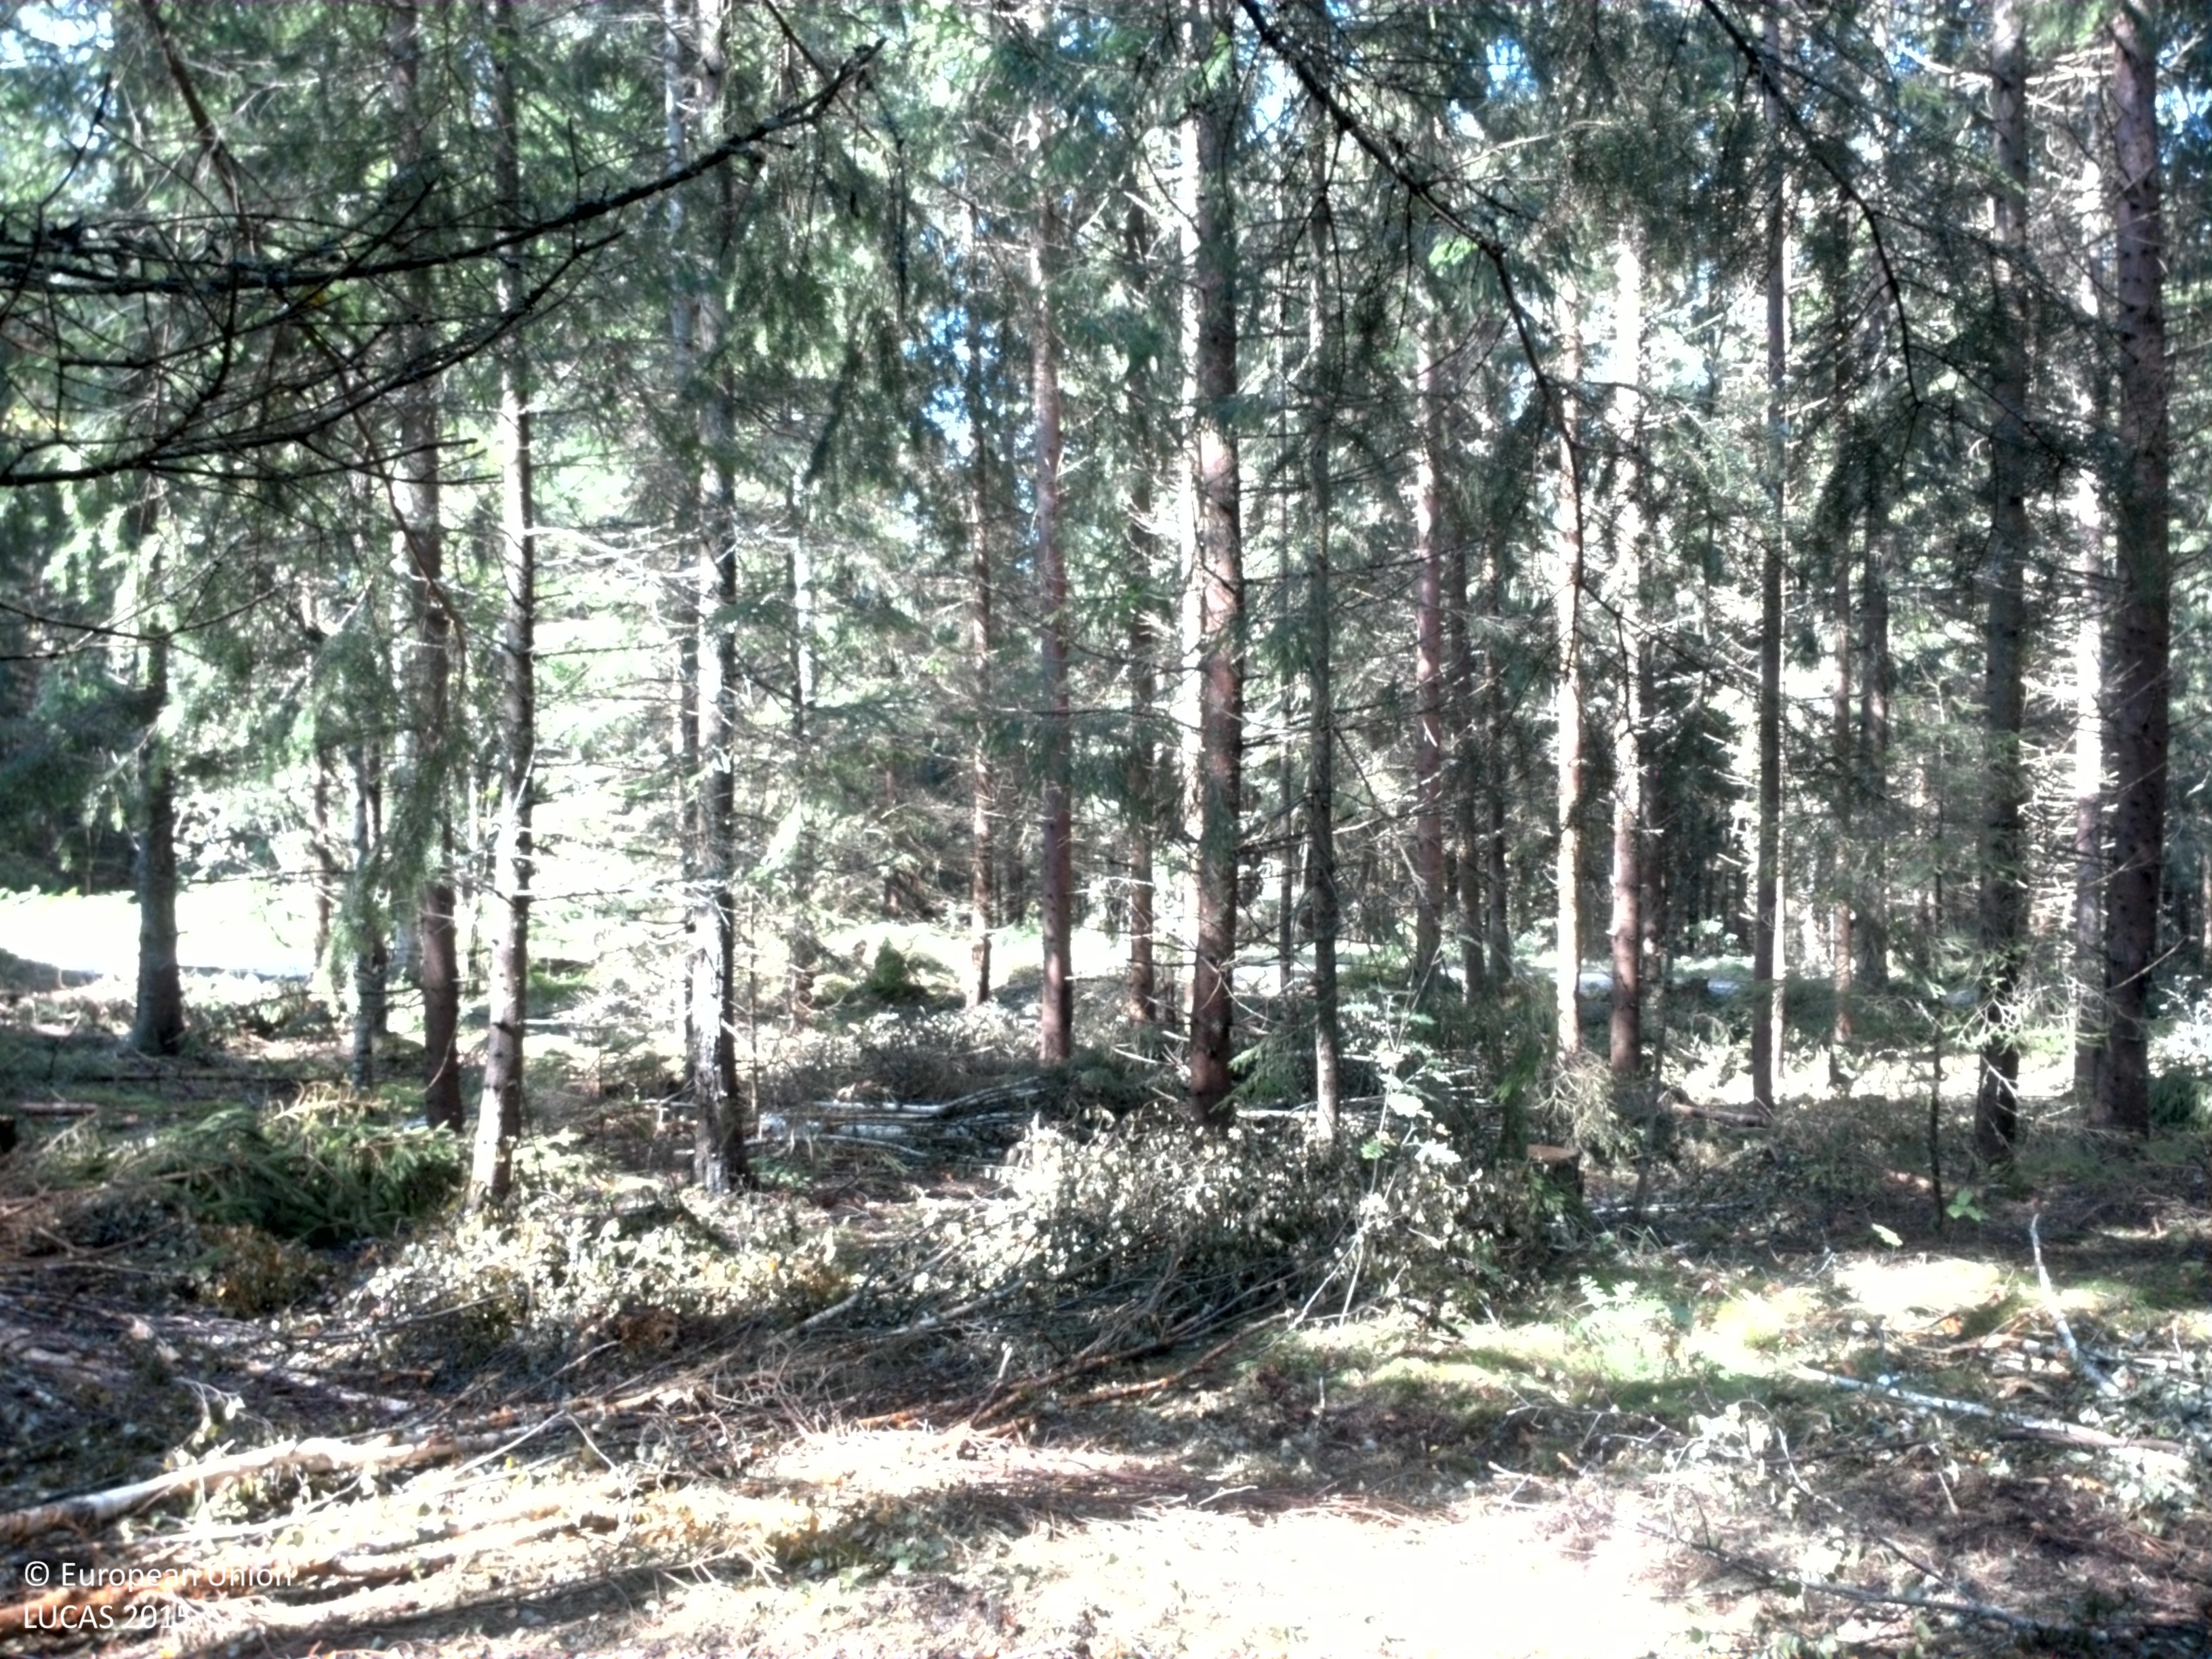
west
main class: Woodland
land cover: Spruce dominated coniferous woodland
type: boreal forest
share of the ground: 50 - 75 %
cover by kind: coniferous forest trees 65 %, lichens and mosses 25 %, shrubs 5 %, herbaceous plants 5 %
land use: Forestry
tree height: > 5 m
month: August
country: SE
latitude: 59.6699
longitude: 13.4536
